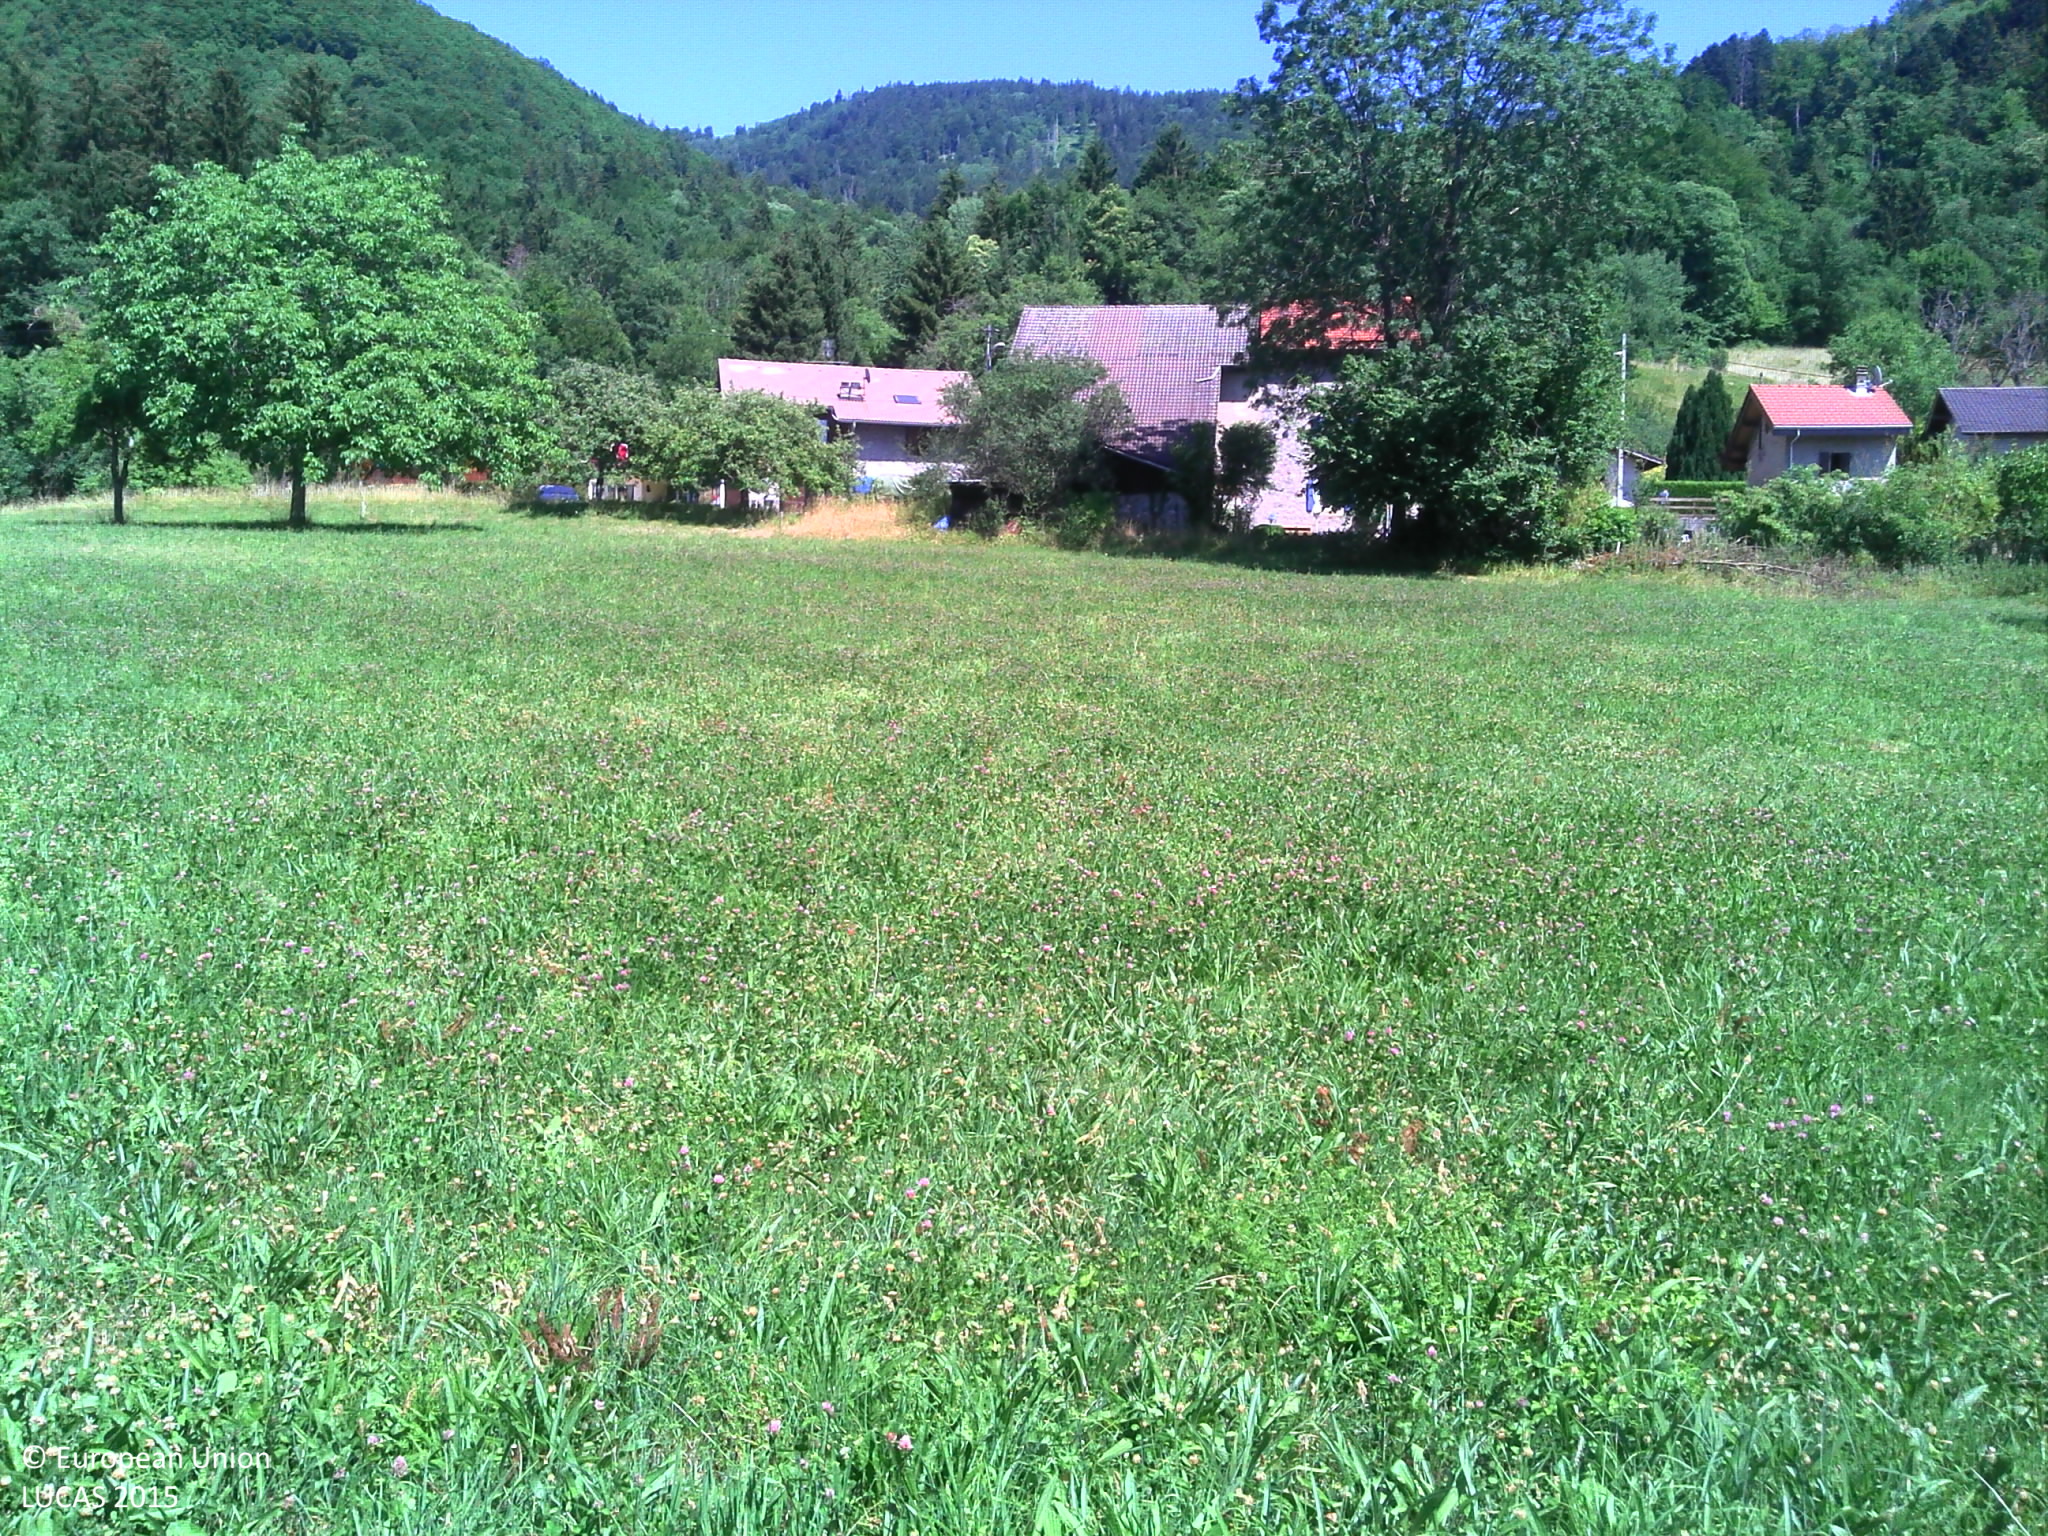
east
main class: Grassland
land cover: Grassland without tree/shrub cover
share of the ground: > 75 %
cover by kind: herbaceous plants 100 %
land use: Agriculture (excluding fallow land and kitchen gardens)
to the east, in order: Grassland without tree/shrub cover; Spontaneously vegetated surfaces; Artificial constructions in urban areas; Broadleaved woodland; Fences; Broadleaved woodland; Fences; Tracks; Spruce dominated mixed woodland; Grassland without tree/shrub cover; Spruce dominated coniferous woodland; Spruce dominated mixed woodland
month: July
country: FR
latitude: 46.2926
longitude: 6.4595
